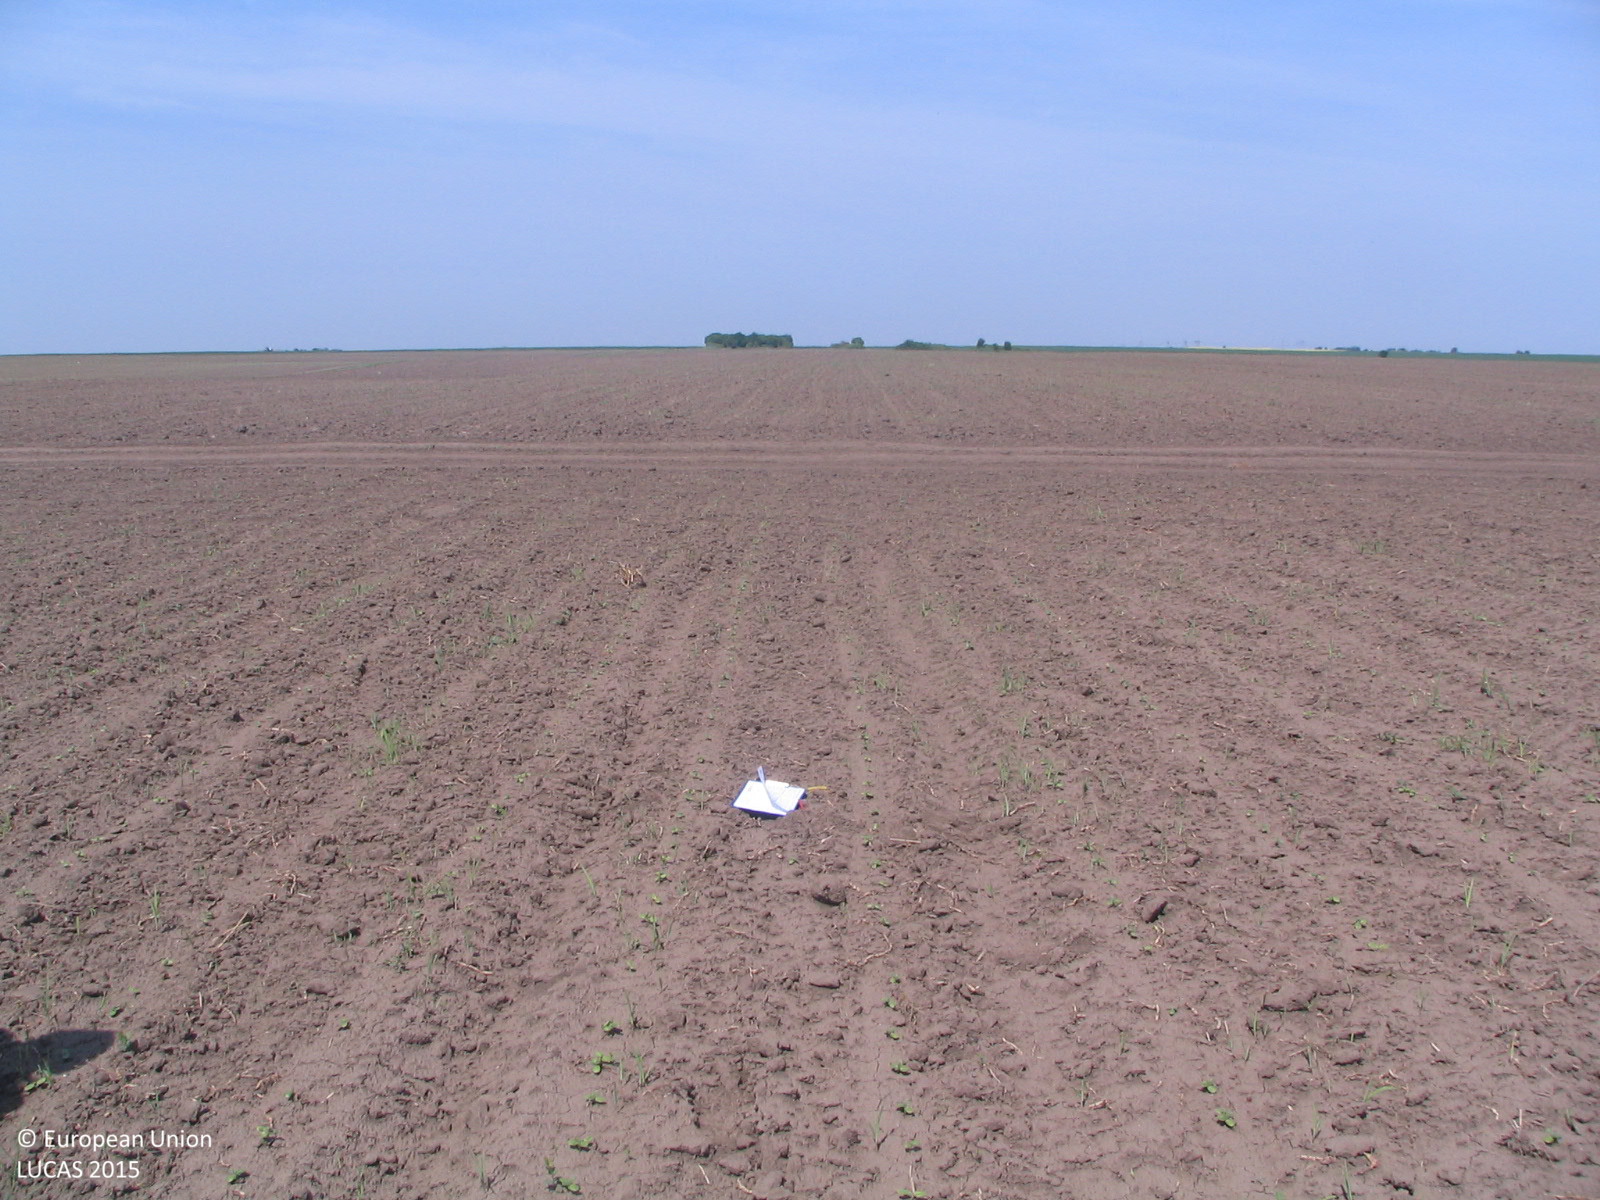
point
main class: Cropland
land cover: Sunflower
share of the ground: < 10 %
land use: Agriculture (excluding fallow land and kitchen gardens)
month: May
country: BG
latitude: 43.6440
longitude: 23.9251
